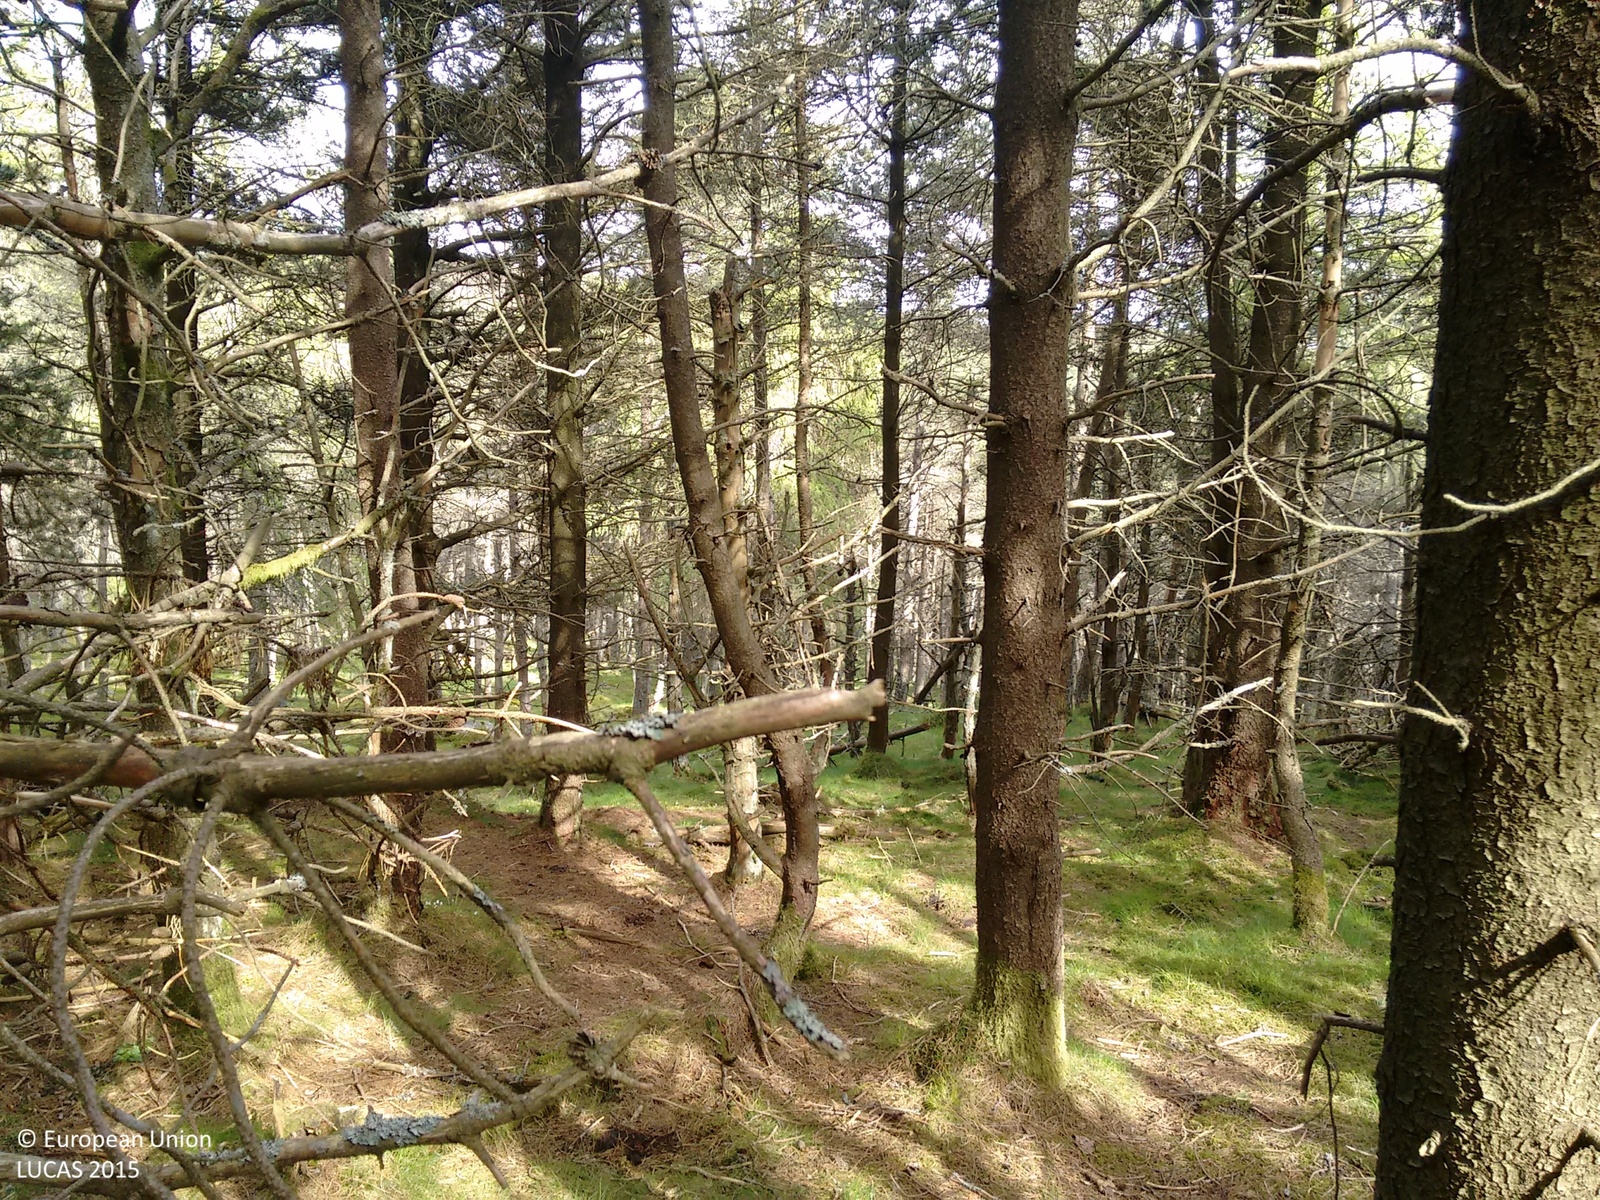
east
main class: Woodland
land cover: Pine dominated coniferous woodland
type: exotic forest
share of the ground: > 75 %
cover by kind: coniferous forest trees 90 %, herbaceous plants 5 %, lichens and mosses 5 %
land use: Forestry
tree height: > 5 m
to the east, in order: Pine dominated coniferous woodland; Rock outcrops; Pine dominated coniferous woodland; Rock outcrops; Spruce dominated coniferous woodland; Ditches and canals; Spruce dominated coniferous woodland; Ditches and canals; Spruce dominated coniferous woodland; Ditches and canals; Spruce dominated coniferous woodland; Ditches and canals; Spruce dominated coniferous woodland
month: May
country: GB
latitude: 56.8203
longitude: -3.1579
